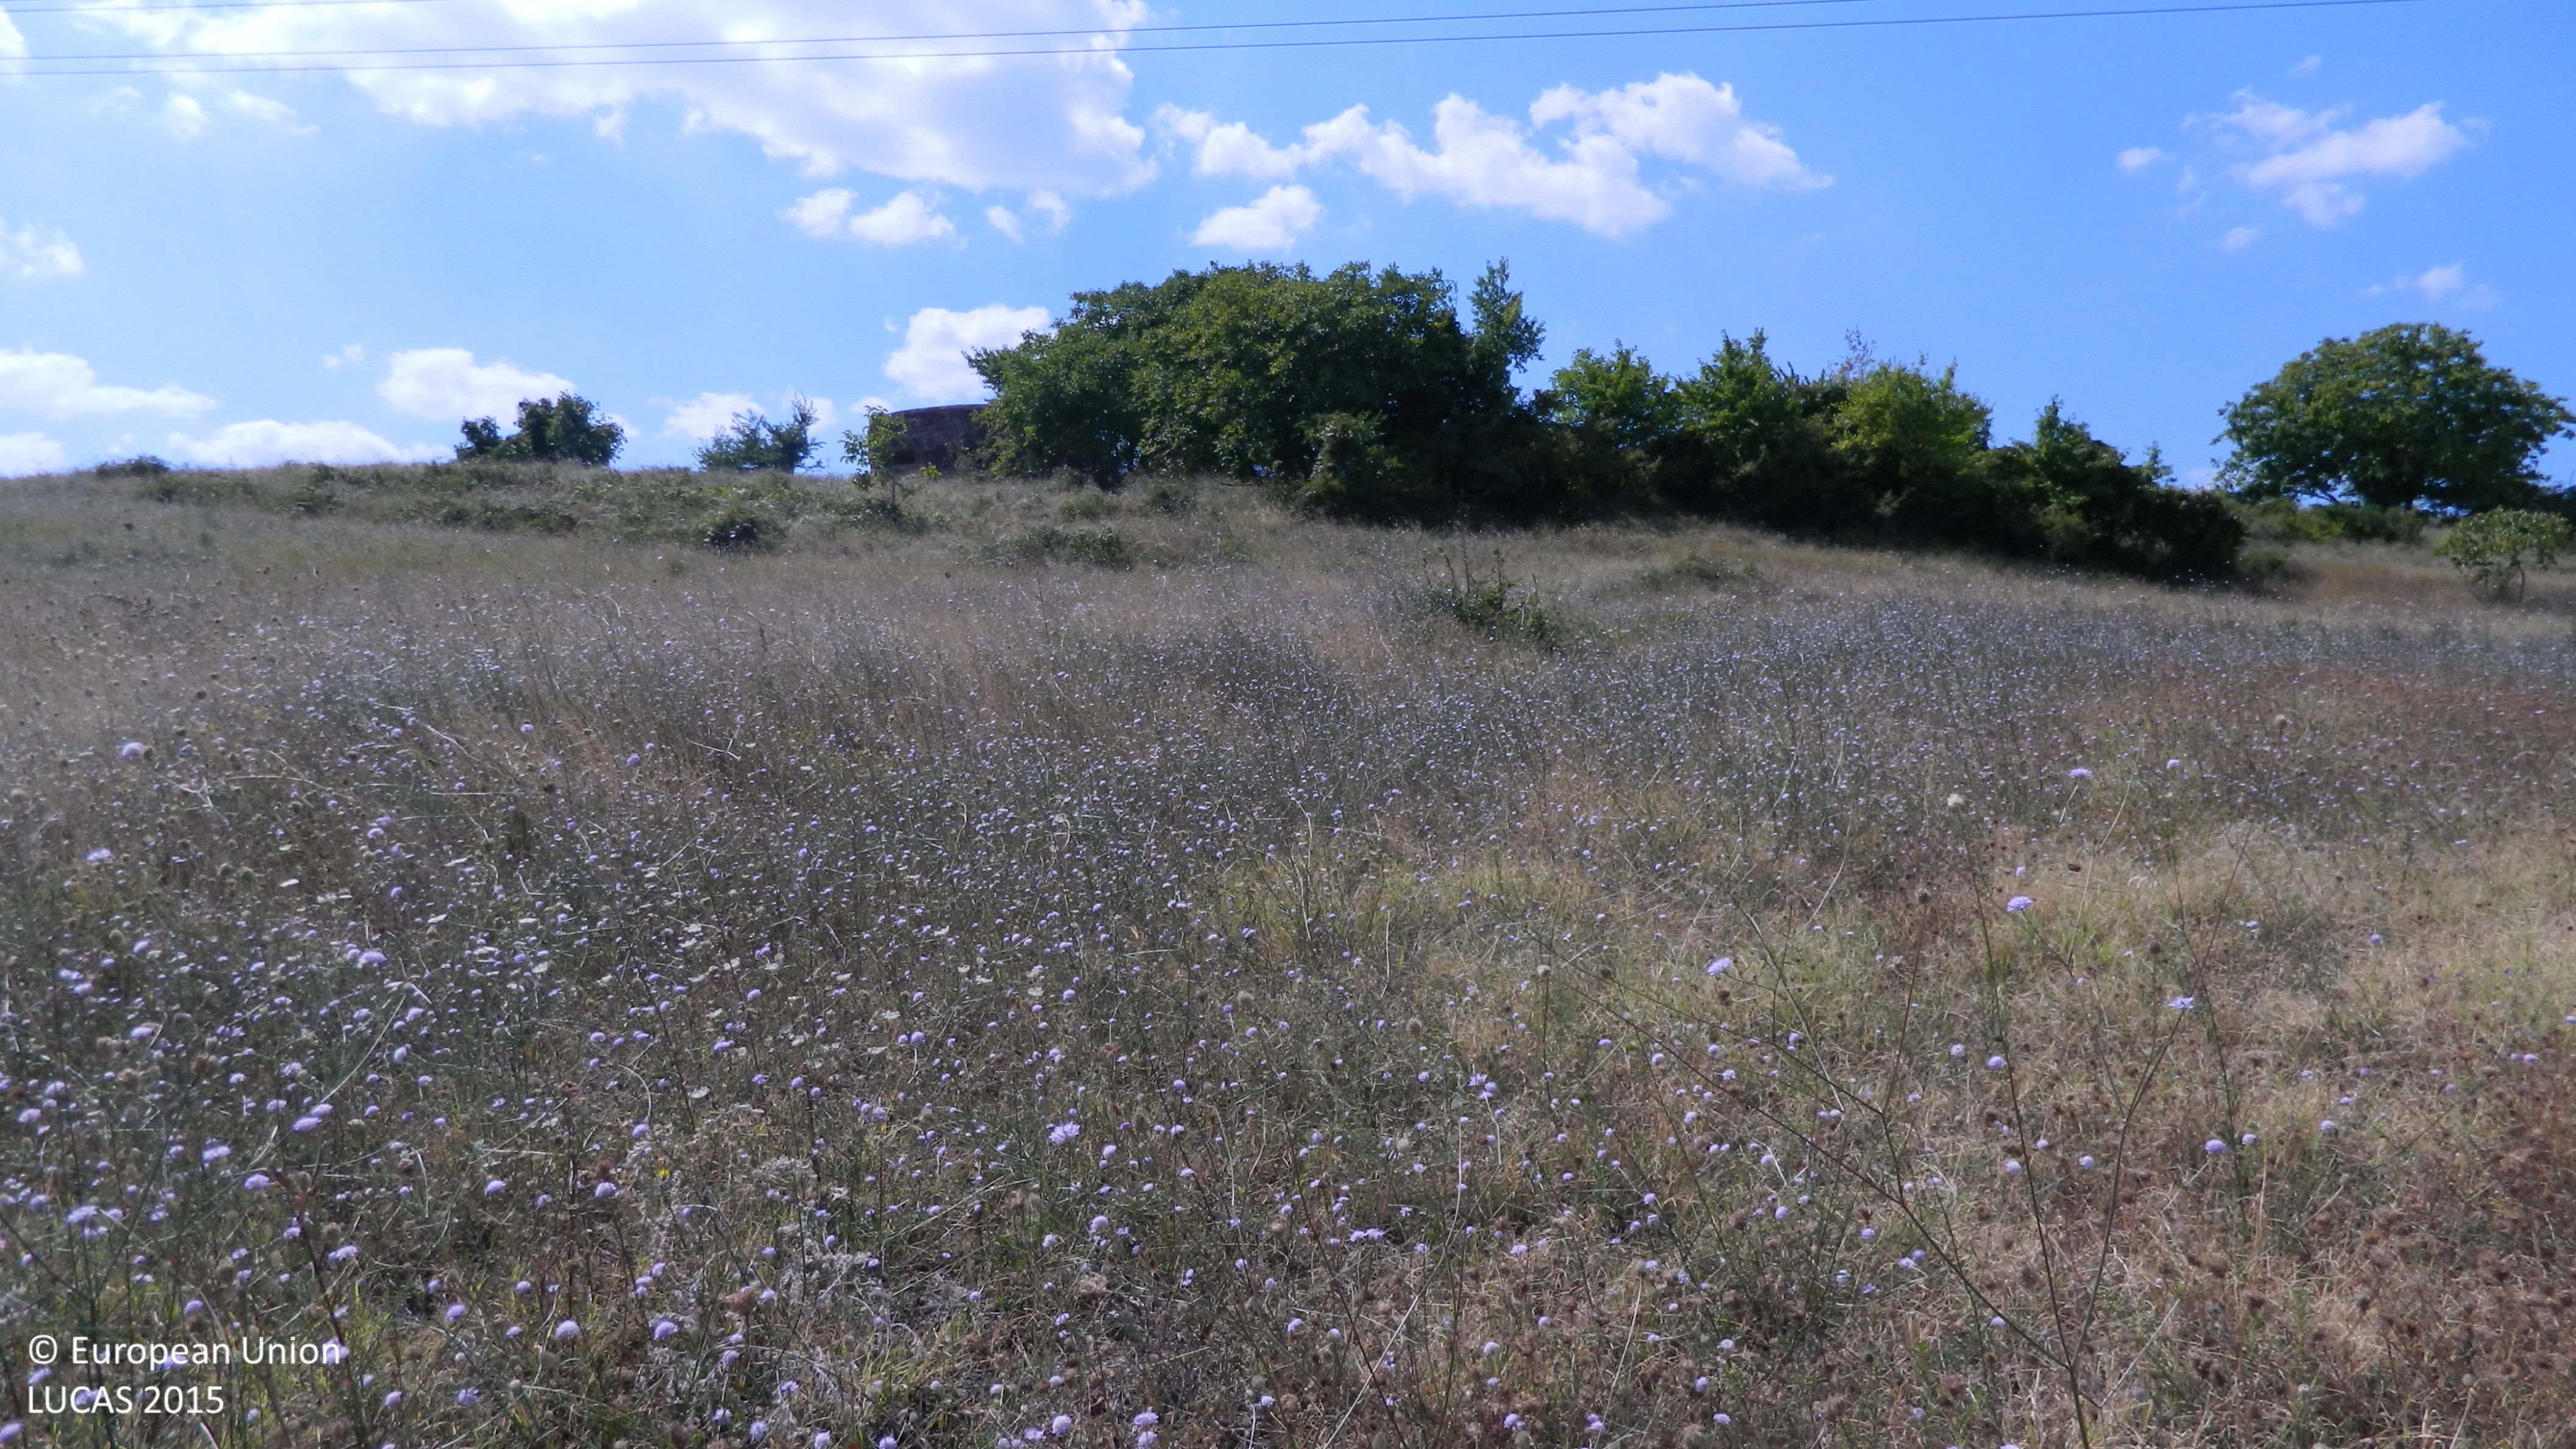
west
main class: Grassland
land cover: Grassland without tree/shrub cover
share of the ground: > 75 %
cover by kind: herbaceous plants 95 %, shrubs 5 %
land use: Agriculture (excluding fallow land and kitchen gardens)
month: August
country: BG
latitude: 41.5190
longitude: 26.1157
